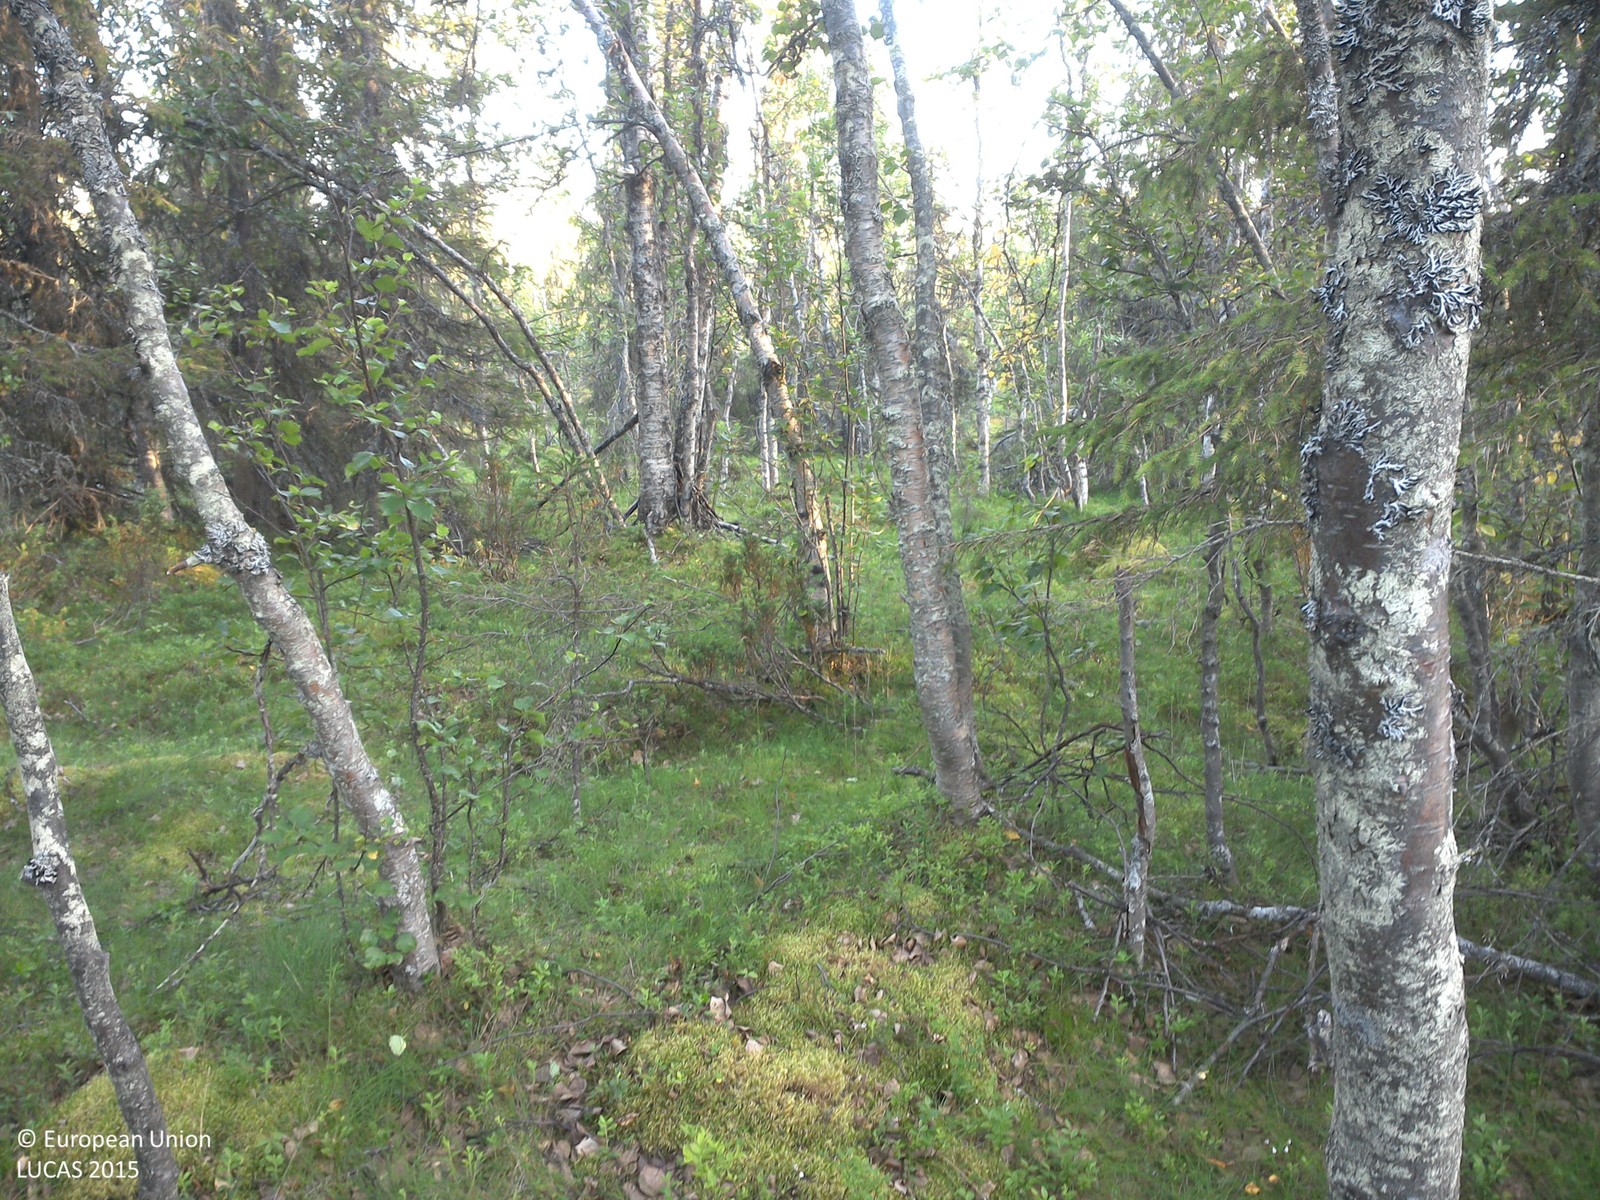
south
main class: Woodland
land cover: Spruce dominated mixed woodland
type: boreal forest
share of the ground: 25 - 50 %
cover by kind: shrubs 40 %, coniferous forest trees 20 %, lichens and mosses 20 %, broadleaved forest trees 15 %, herbaceous plants 5 %
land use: Forestry
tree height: > 5 m
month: August
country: SE
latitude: 67.3009
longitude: 21.1196
